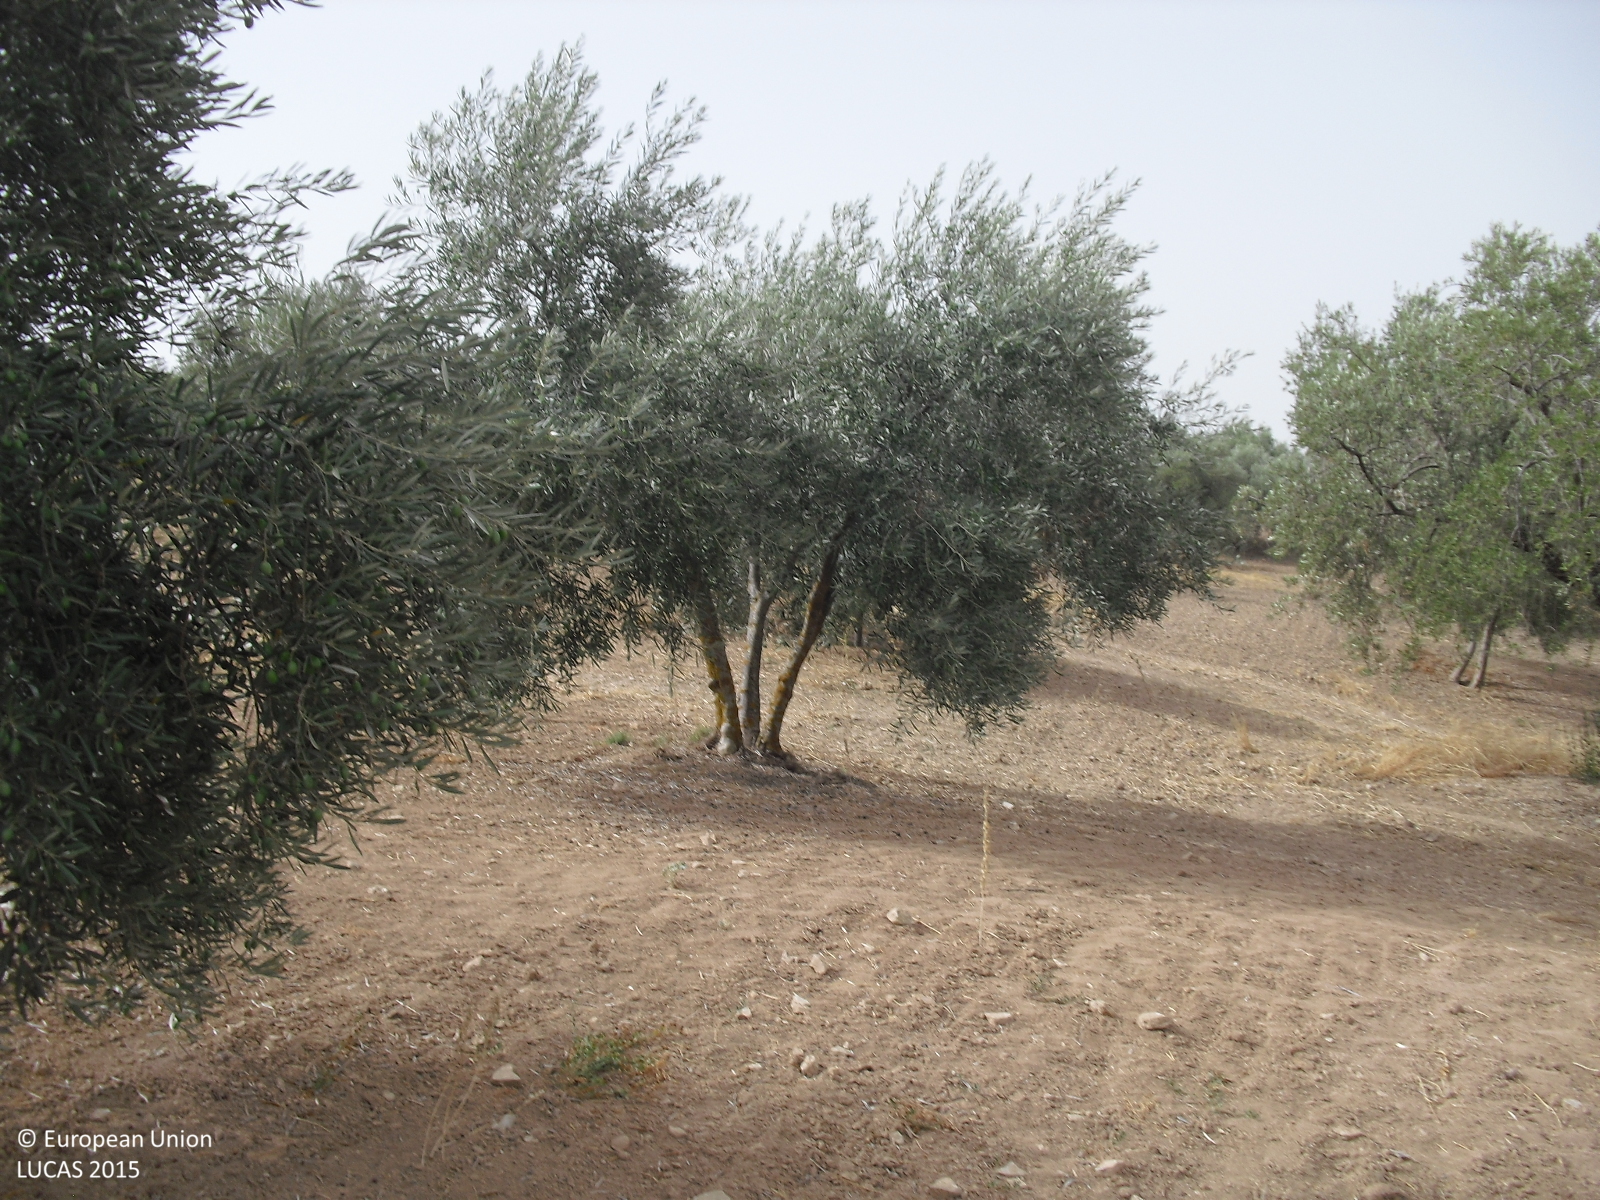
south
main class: Cropland
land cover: Olive groves
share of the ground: 10 - 25 %
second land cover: Spontaneously vegetated surfaces
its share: 10 - 25 %
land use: Agriculture (excluding fallow land and kitchen gardens)
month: August
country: ES
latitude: 37.2117
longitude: -4.1826
